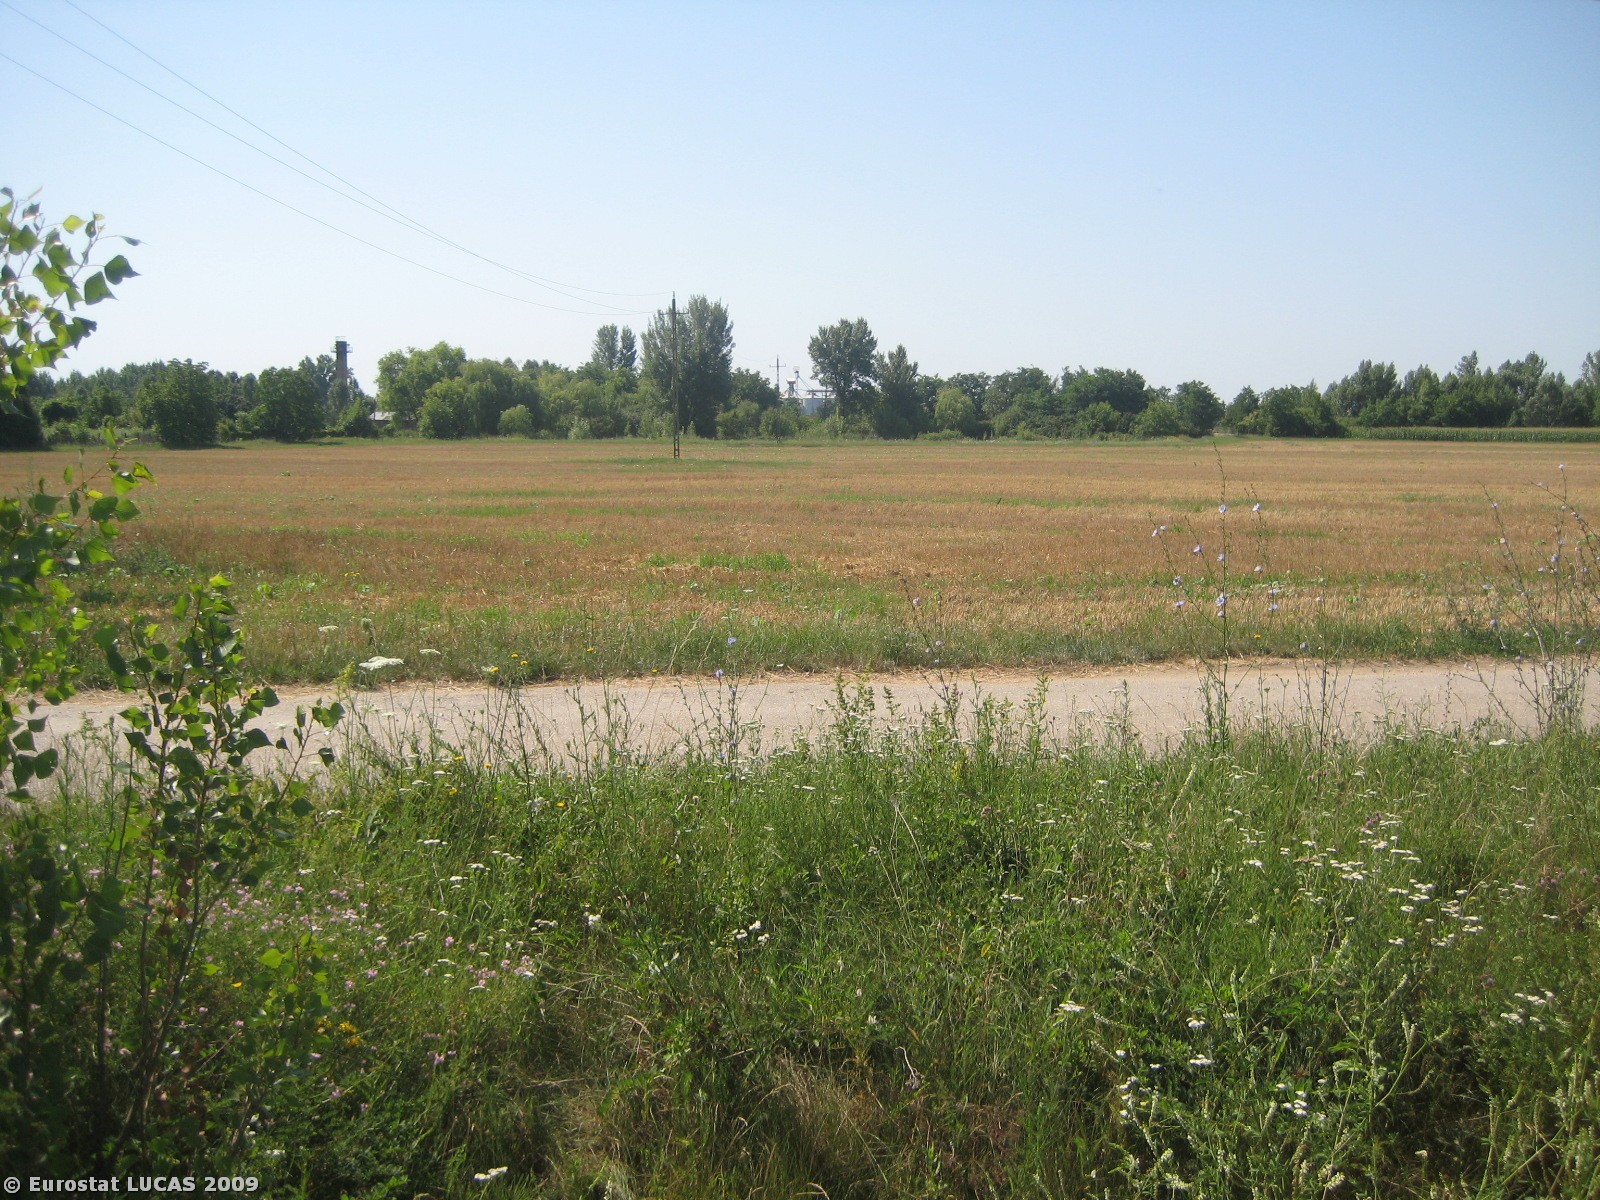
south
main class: Grassland
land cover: Spontaneously vegetated surfaces
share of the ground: 50 - 75 %
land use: Unused
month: July
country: HU
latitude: 47.1421
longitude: 21.7135
